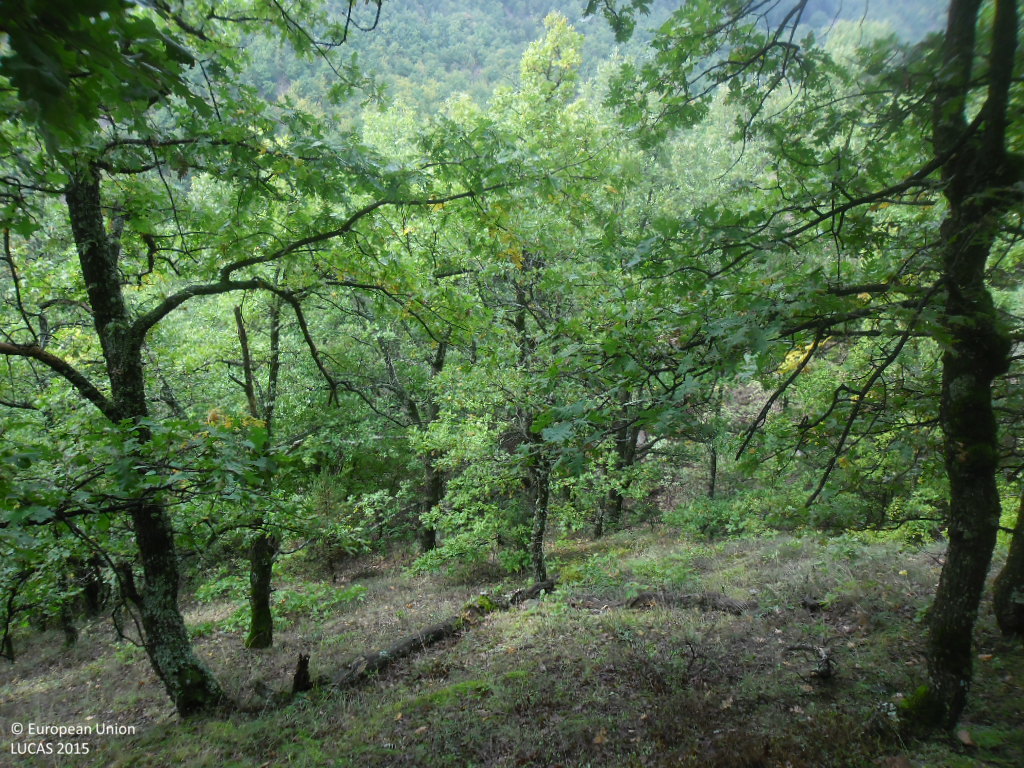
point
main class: Woodland
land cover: Broadleaved woodland
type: mesophytic deciduous forest
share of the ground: > 75 %
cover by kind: broadleaved forest trees 95 %, unconsolidated bare surface 5 %
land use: Forestry
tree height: > 5 m
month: October
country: BG
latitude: 41.9345
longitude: 23.1825
